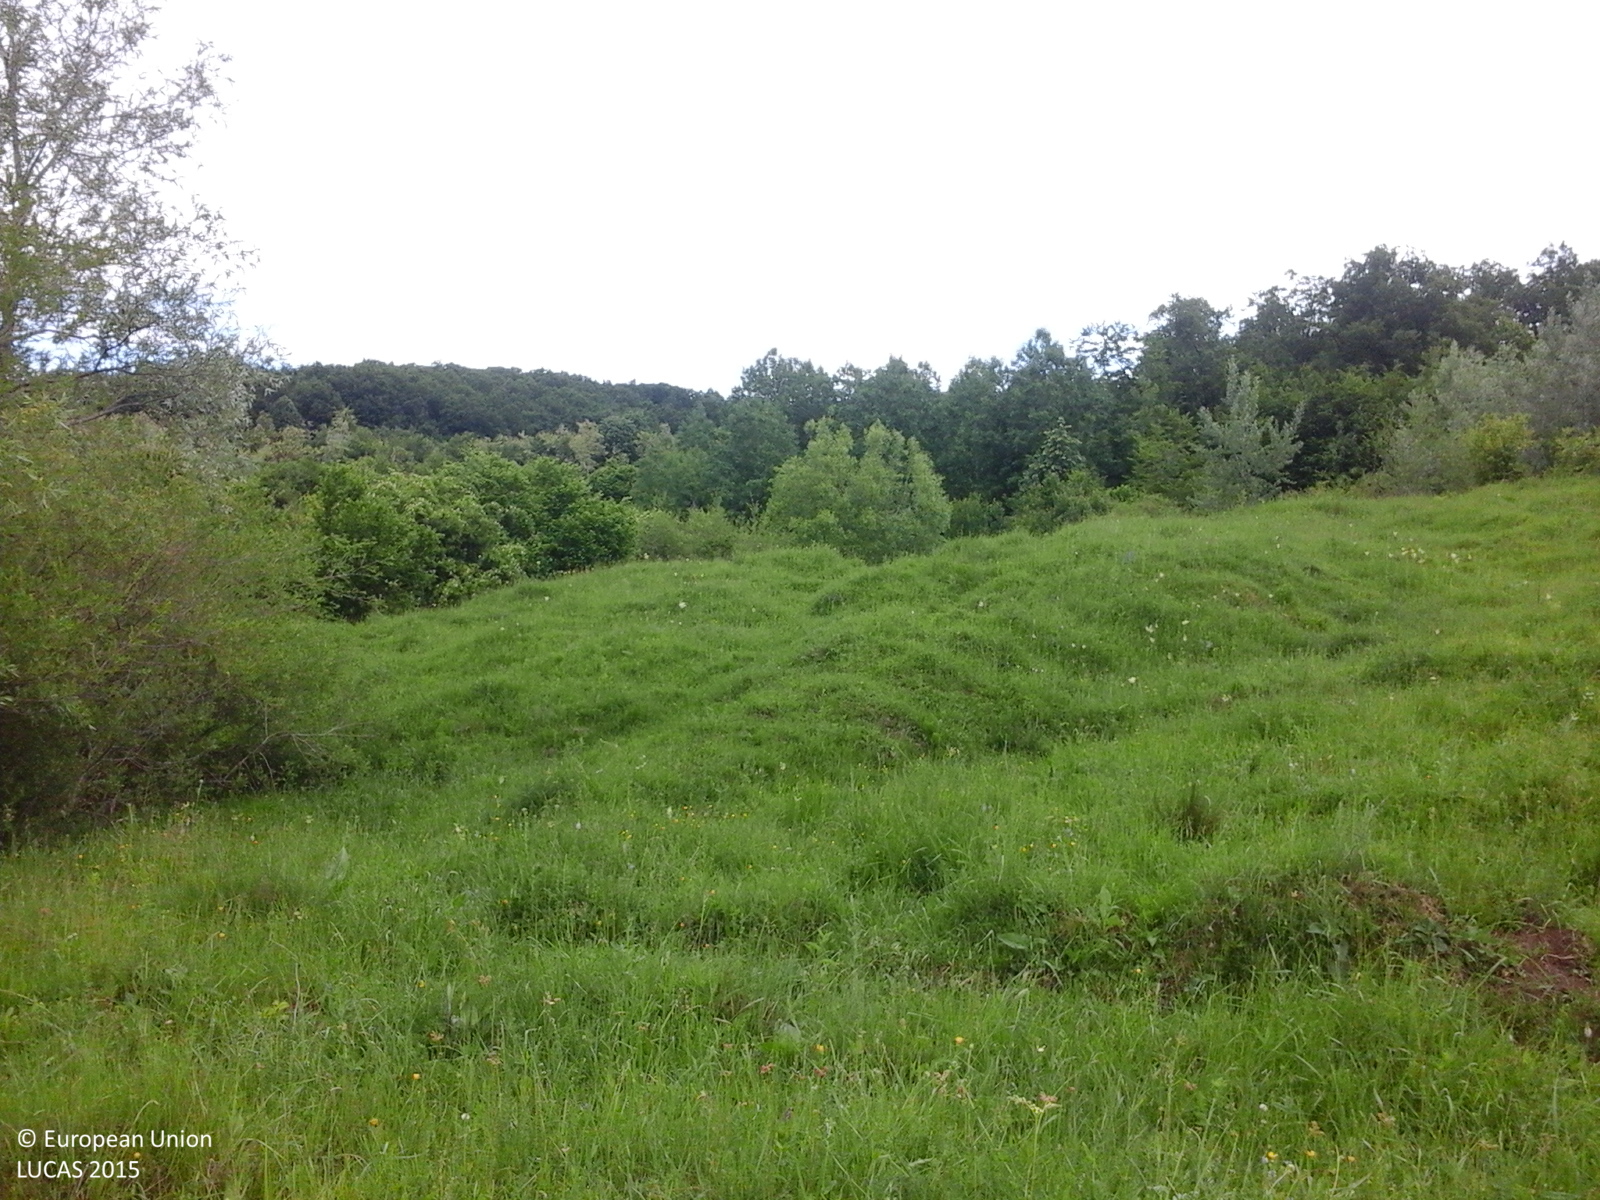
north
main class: Grassland
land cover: Grassland with sparse tree/shrub cover
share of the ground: > 75 %
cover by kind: herbaceous plants 85 %, shrubs 10 %, broadleaved forest trees 5 %
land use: Agriculture (excluding fallow land and kitchen gardens)
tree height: < 5 m
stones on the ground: < 10 %
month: May
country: RO
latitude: 45.1967
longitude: 26.0877
